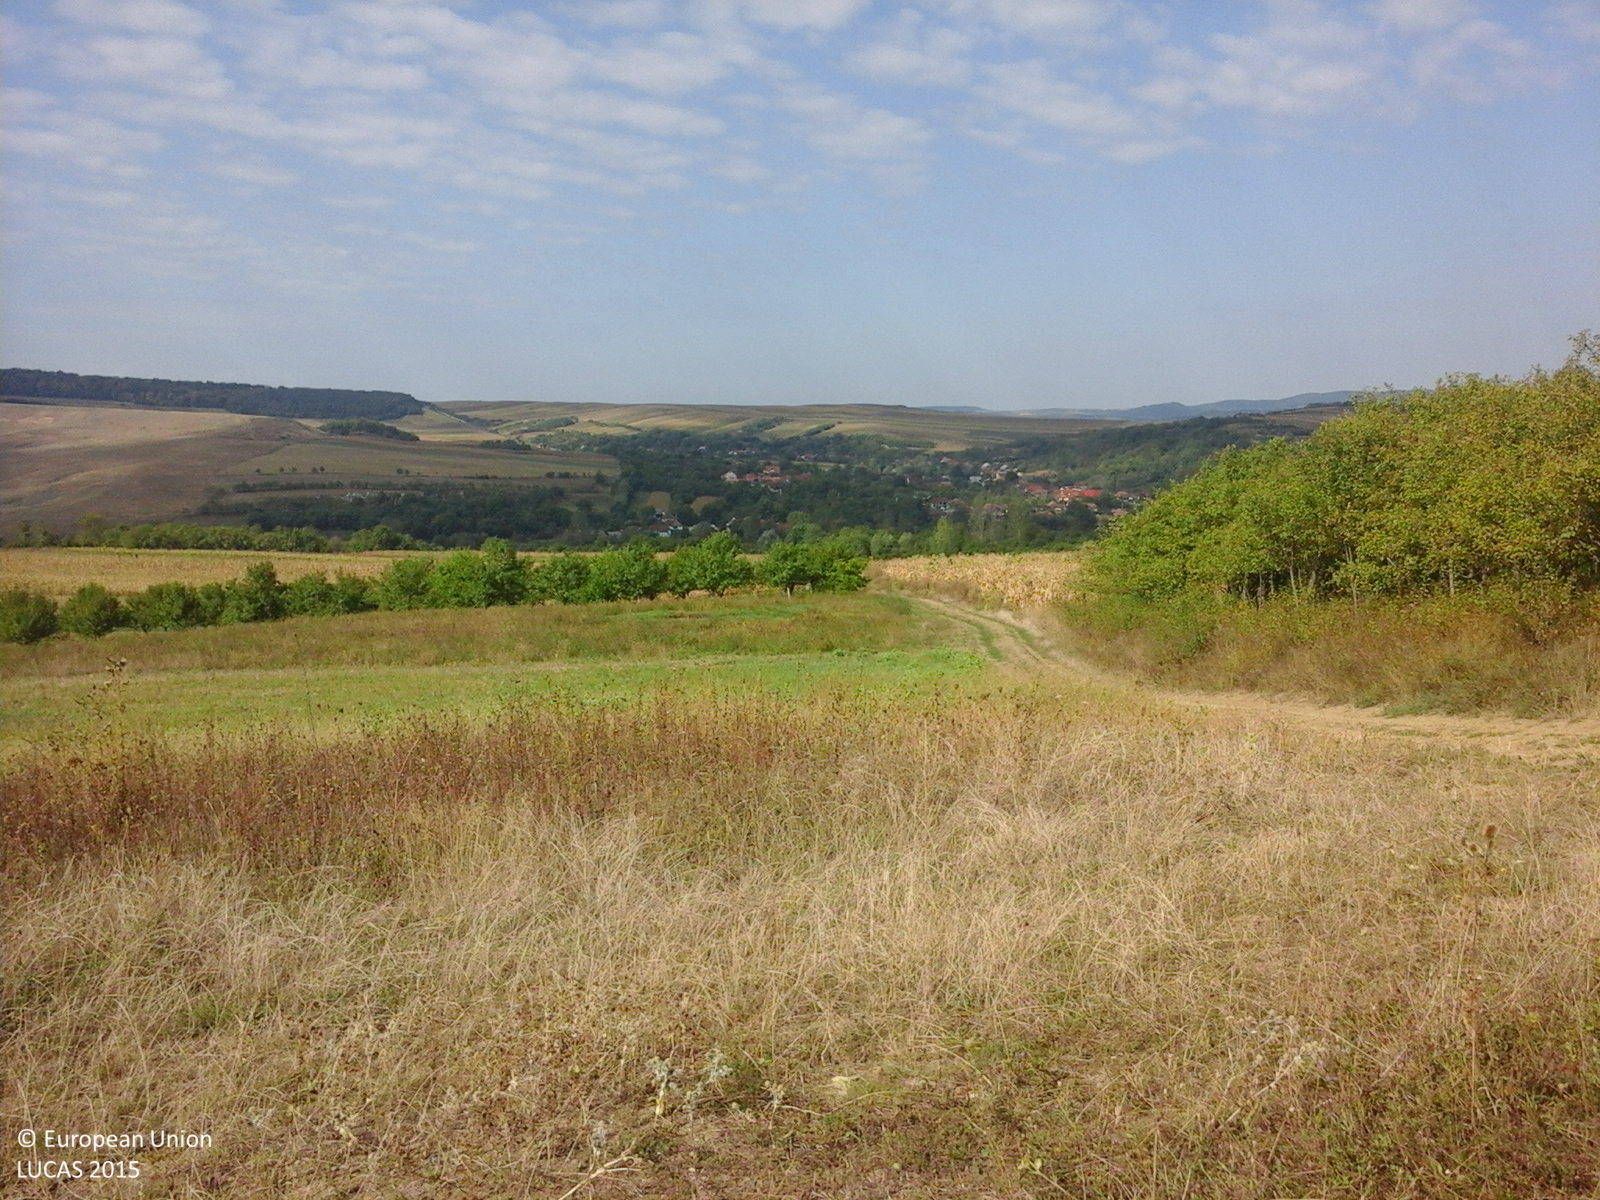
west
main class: Grassland
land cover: Spontaneously vegetated surfaces
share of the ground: > 75 %
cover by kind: herbaceous plants 100 %
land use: Fallow land
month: September
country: RO
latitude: 47.4571
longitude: 23.2405
